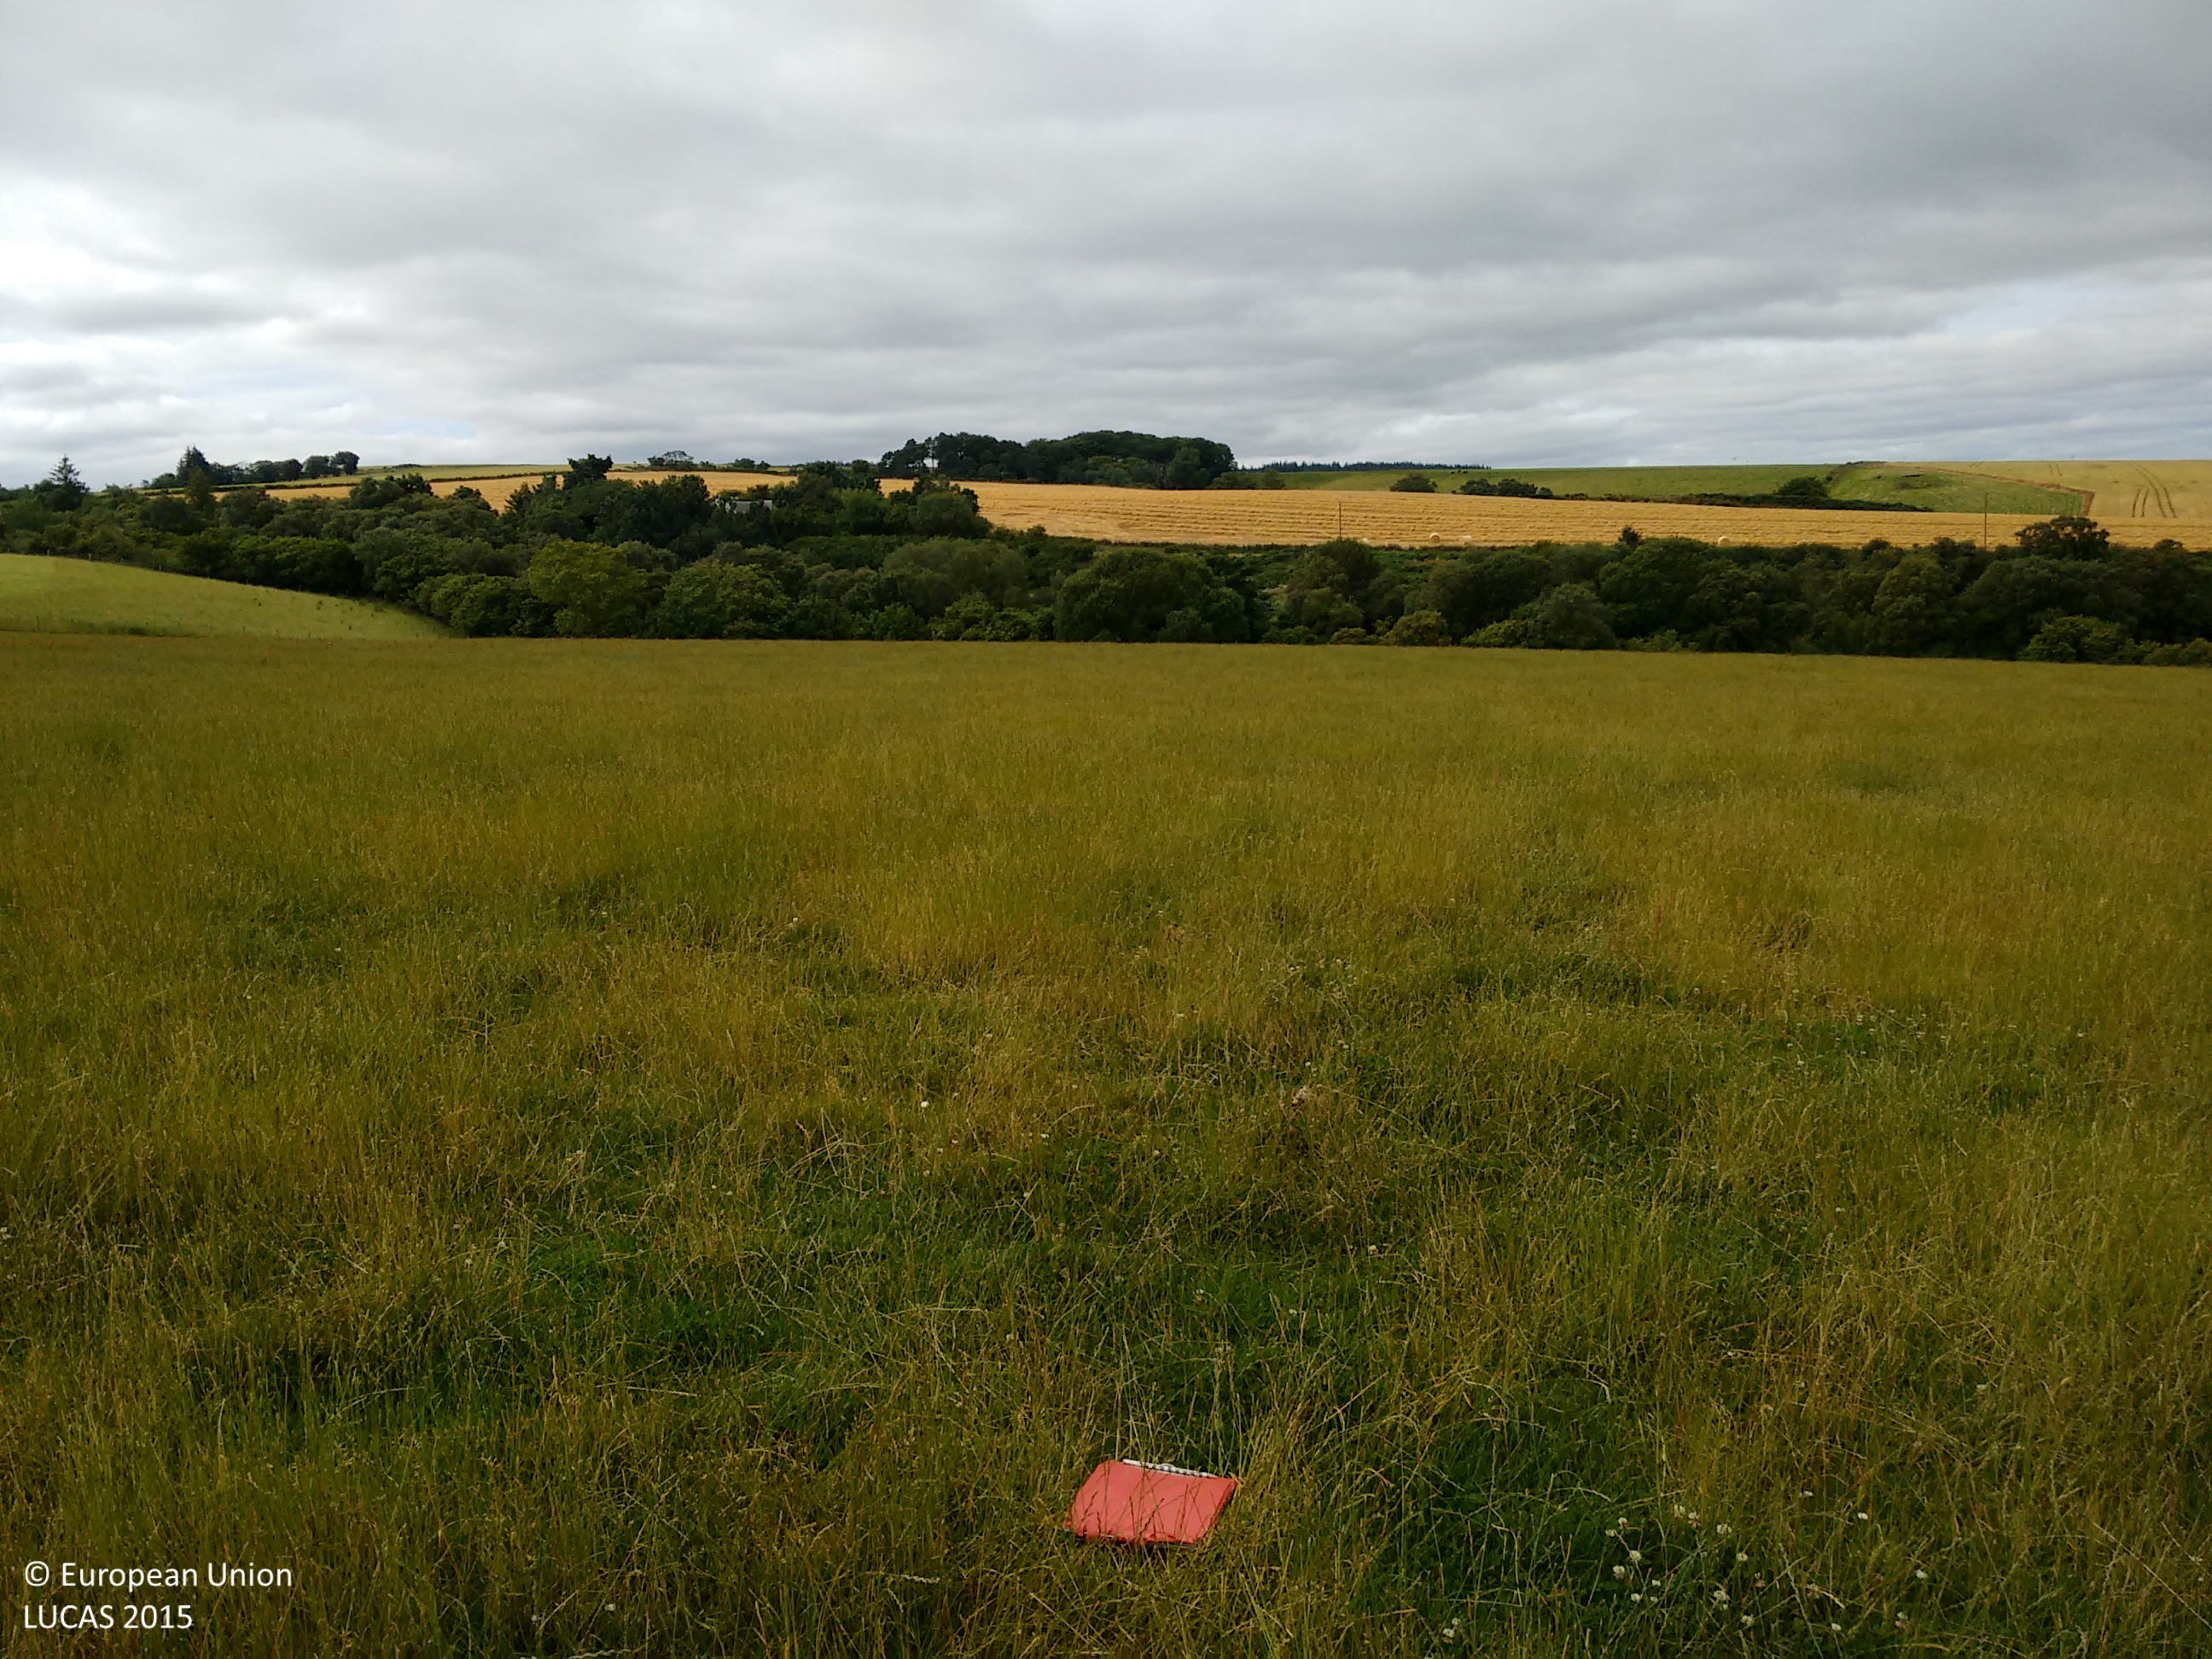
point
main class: Grassland
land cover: Grassland without tree/shrub cover
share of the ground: > 75 %
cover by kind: herbaceous plants 100 %
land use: Agriculture (excluding fallow land and kitchen gardens)
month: August
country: GB
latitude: 57.6208
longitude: -3.0026
